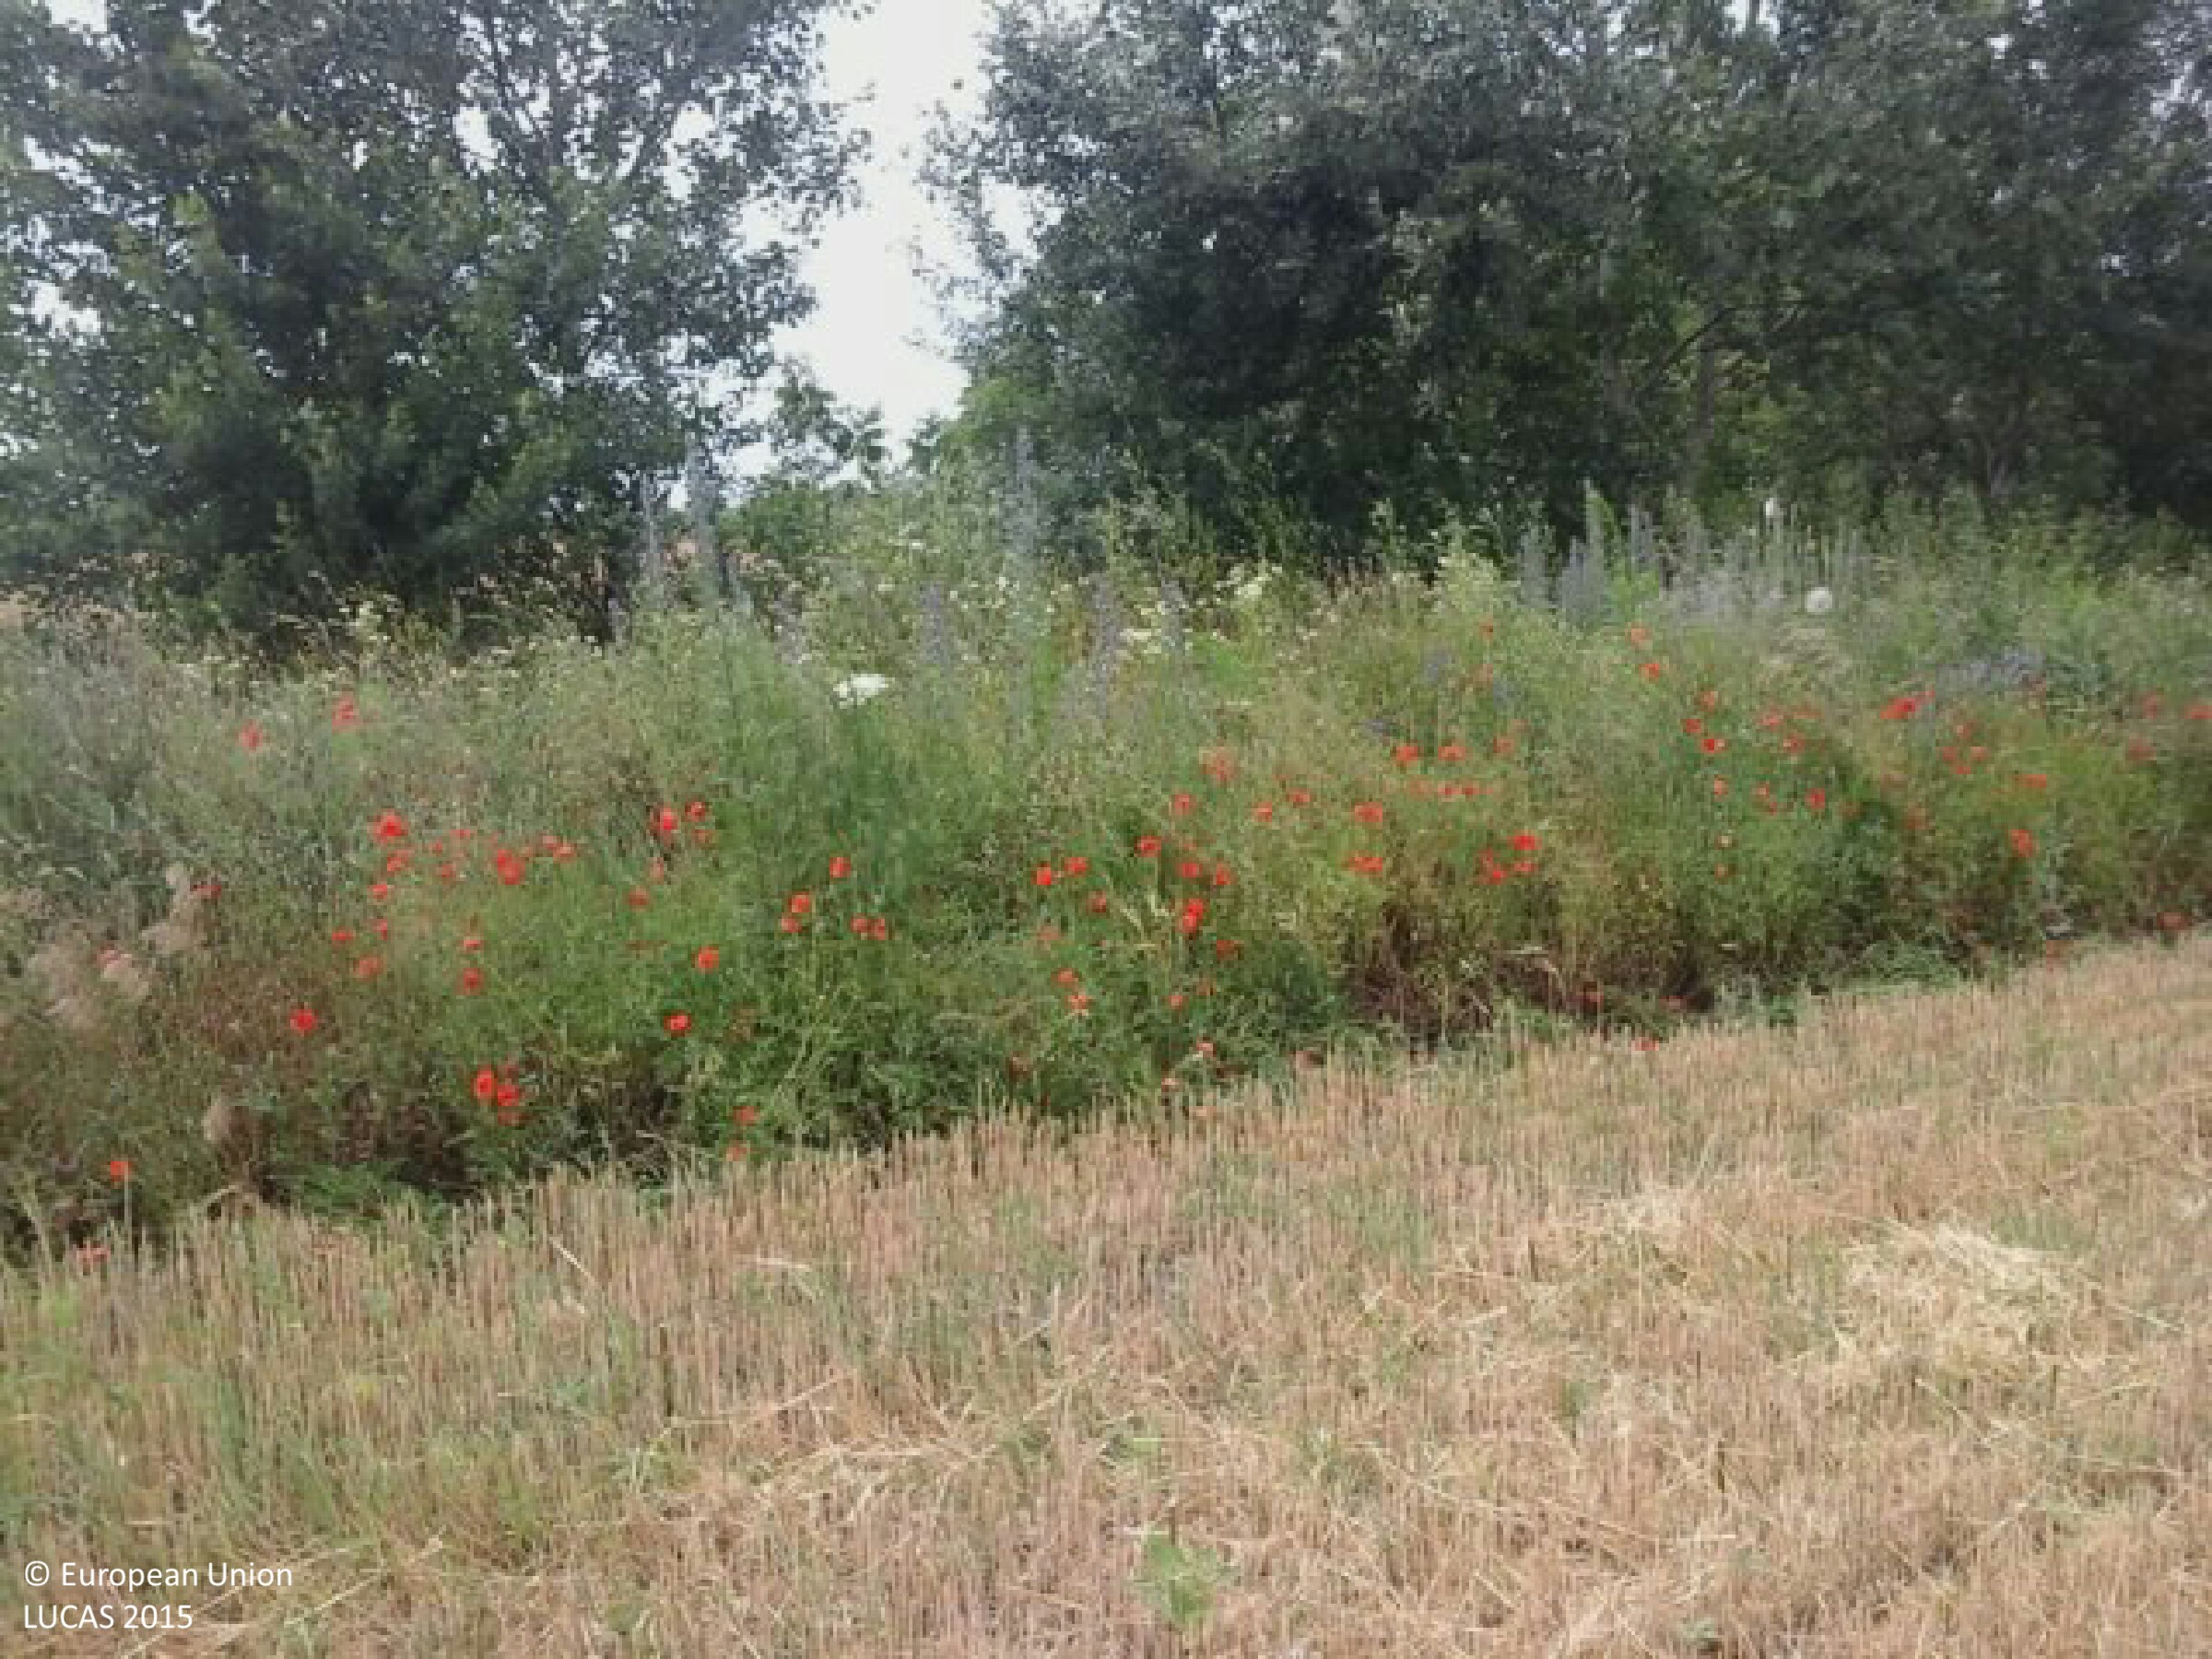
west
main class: Cropland
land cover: Barley
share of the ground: 50 - 75 %
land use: Agriculture (excluding fallow land and kitchen gardens)
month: June
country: HU
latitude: 46.2068
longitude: 20.0133
